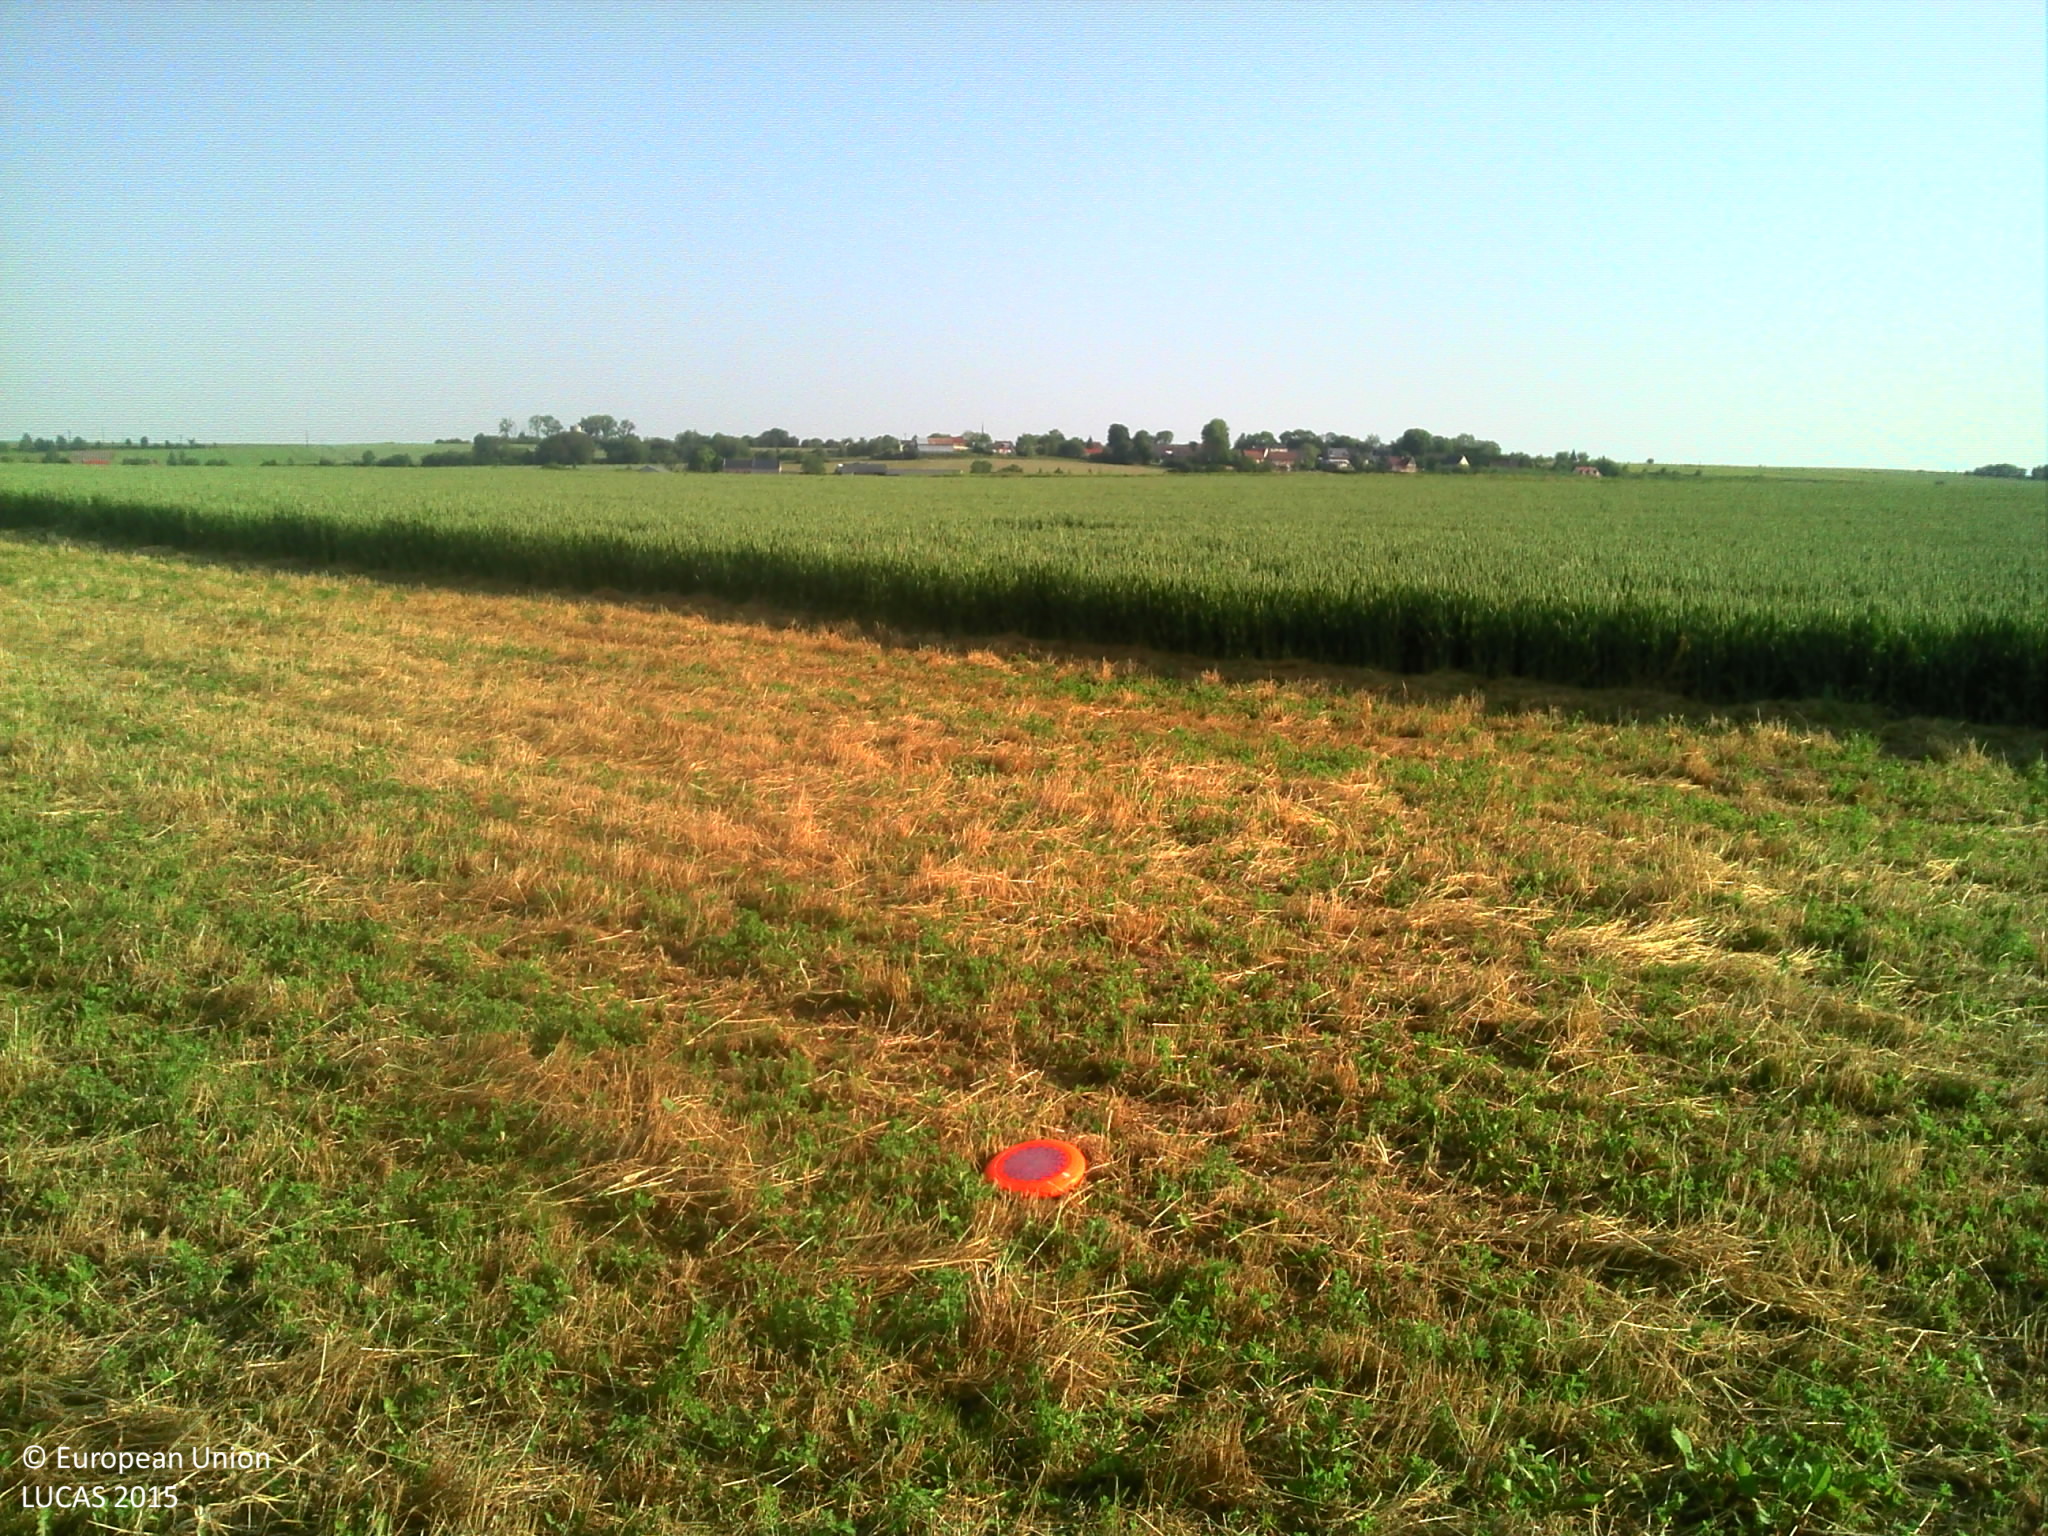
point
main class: Cropland
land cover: Lucerne
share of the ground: > 75 %
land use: Agriculture (excluding fallow land and kitchen gardens)
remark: Harvested field
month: June
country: FR
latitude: 49.8435
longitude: 2.1846
